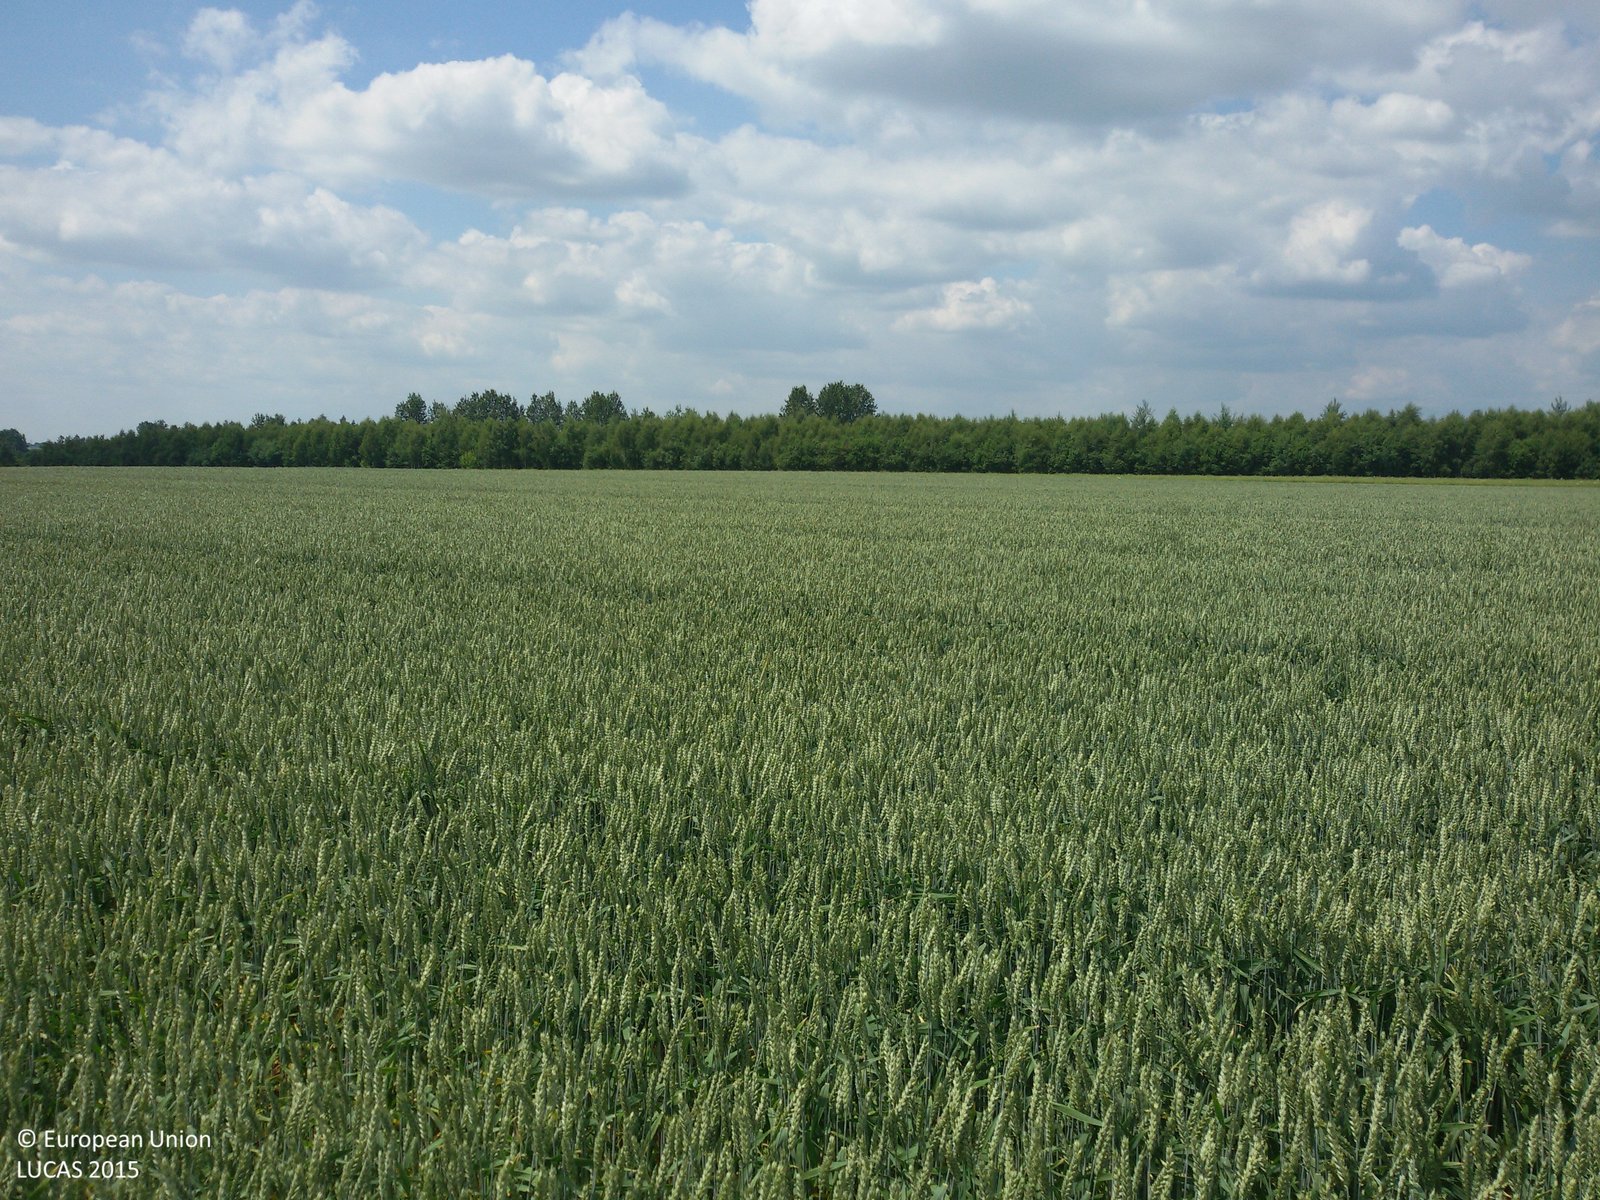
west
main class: Cropland
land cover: Common wheat
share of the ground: > 75 %
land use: Agriculture (excluding fallow land and kitchen gardens)
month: June
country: PL
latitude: 50.8677
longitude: 21.7199
